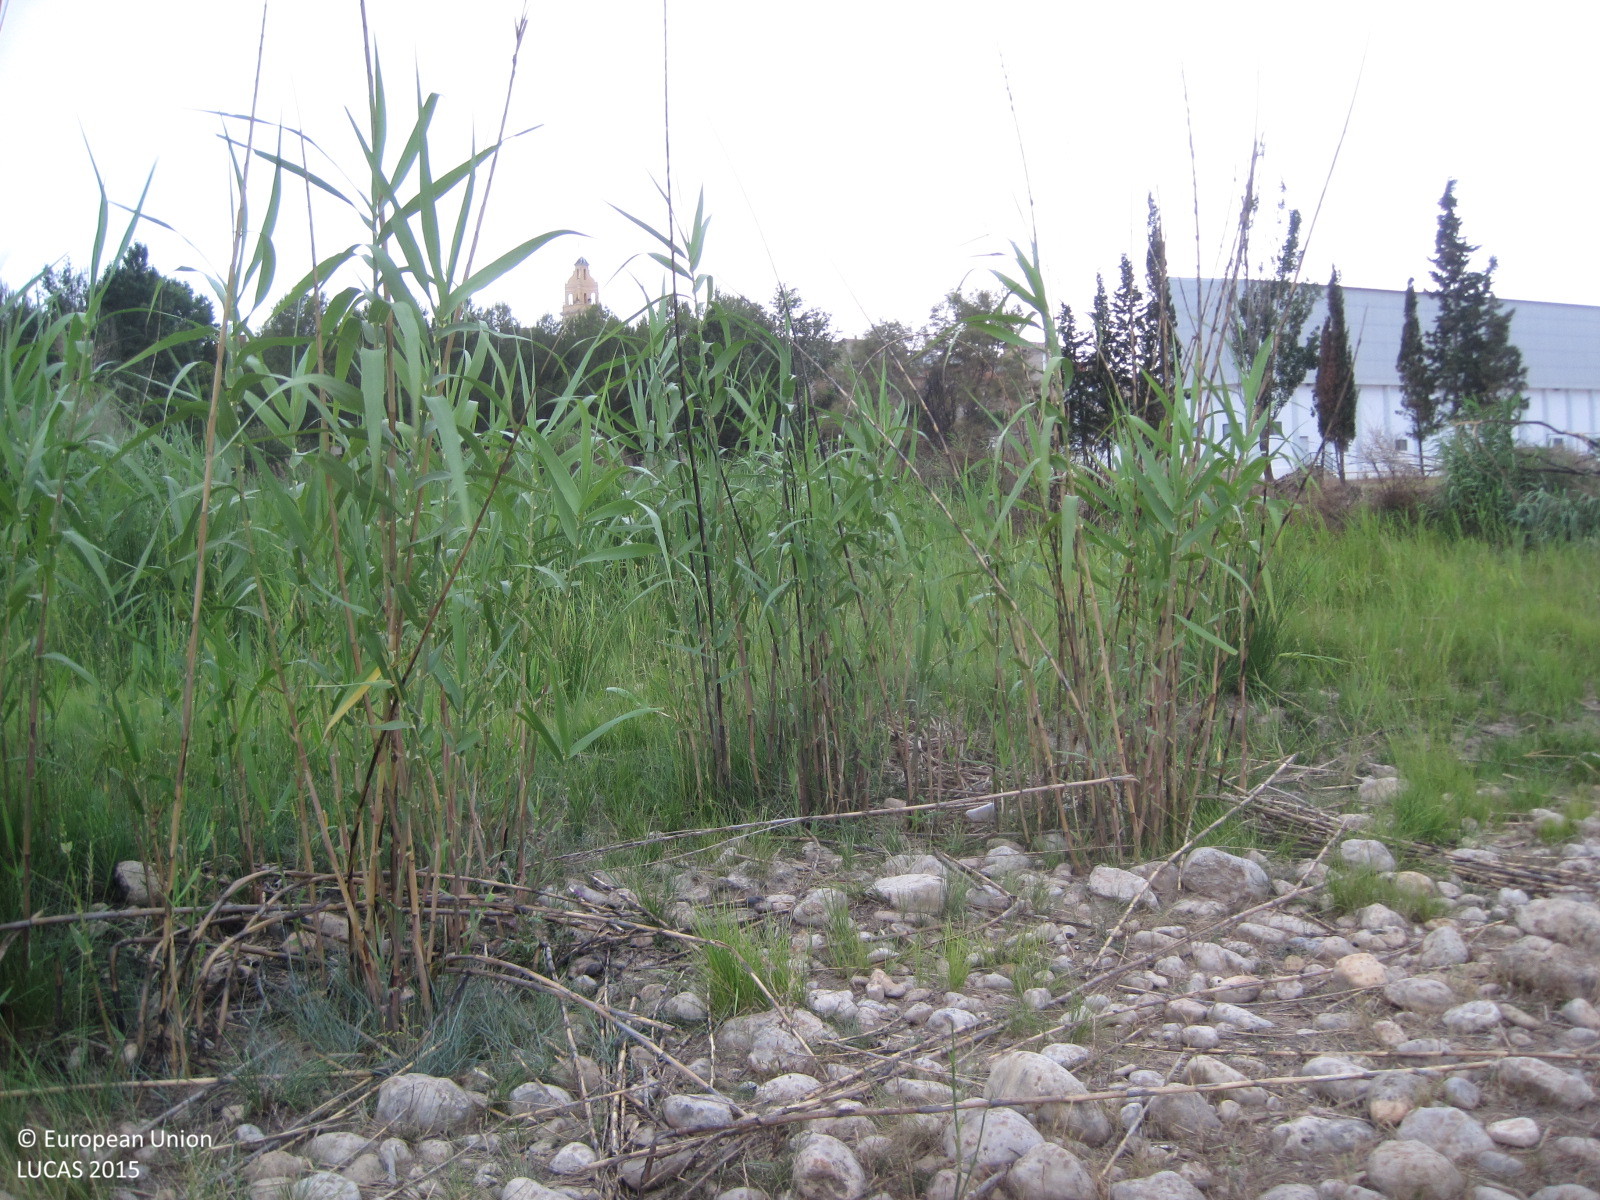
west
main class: Grassland
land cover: Grassland without tree/shrub cover
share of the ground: 50 - 75 %
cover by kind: herbaceous plants 70 %, unconsolidated bare surface 25 %, shrubs 5 %
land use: Semi-natural and natural areas not in use
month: June
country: ES
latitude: 39.2767
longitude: -0.5563
